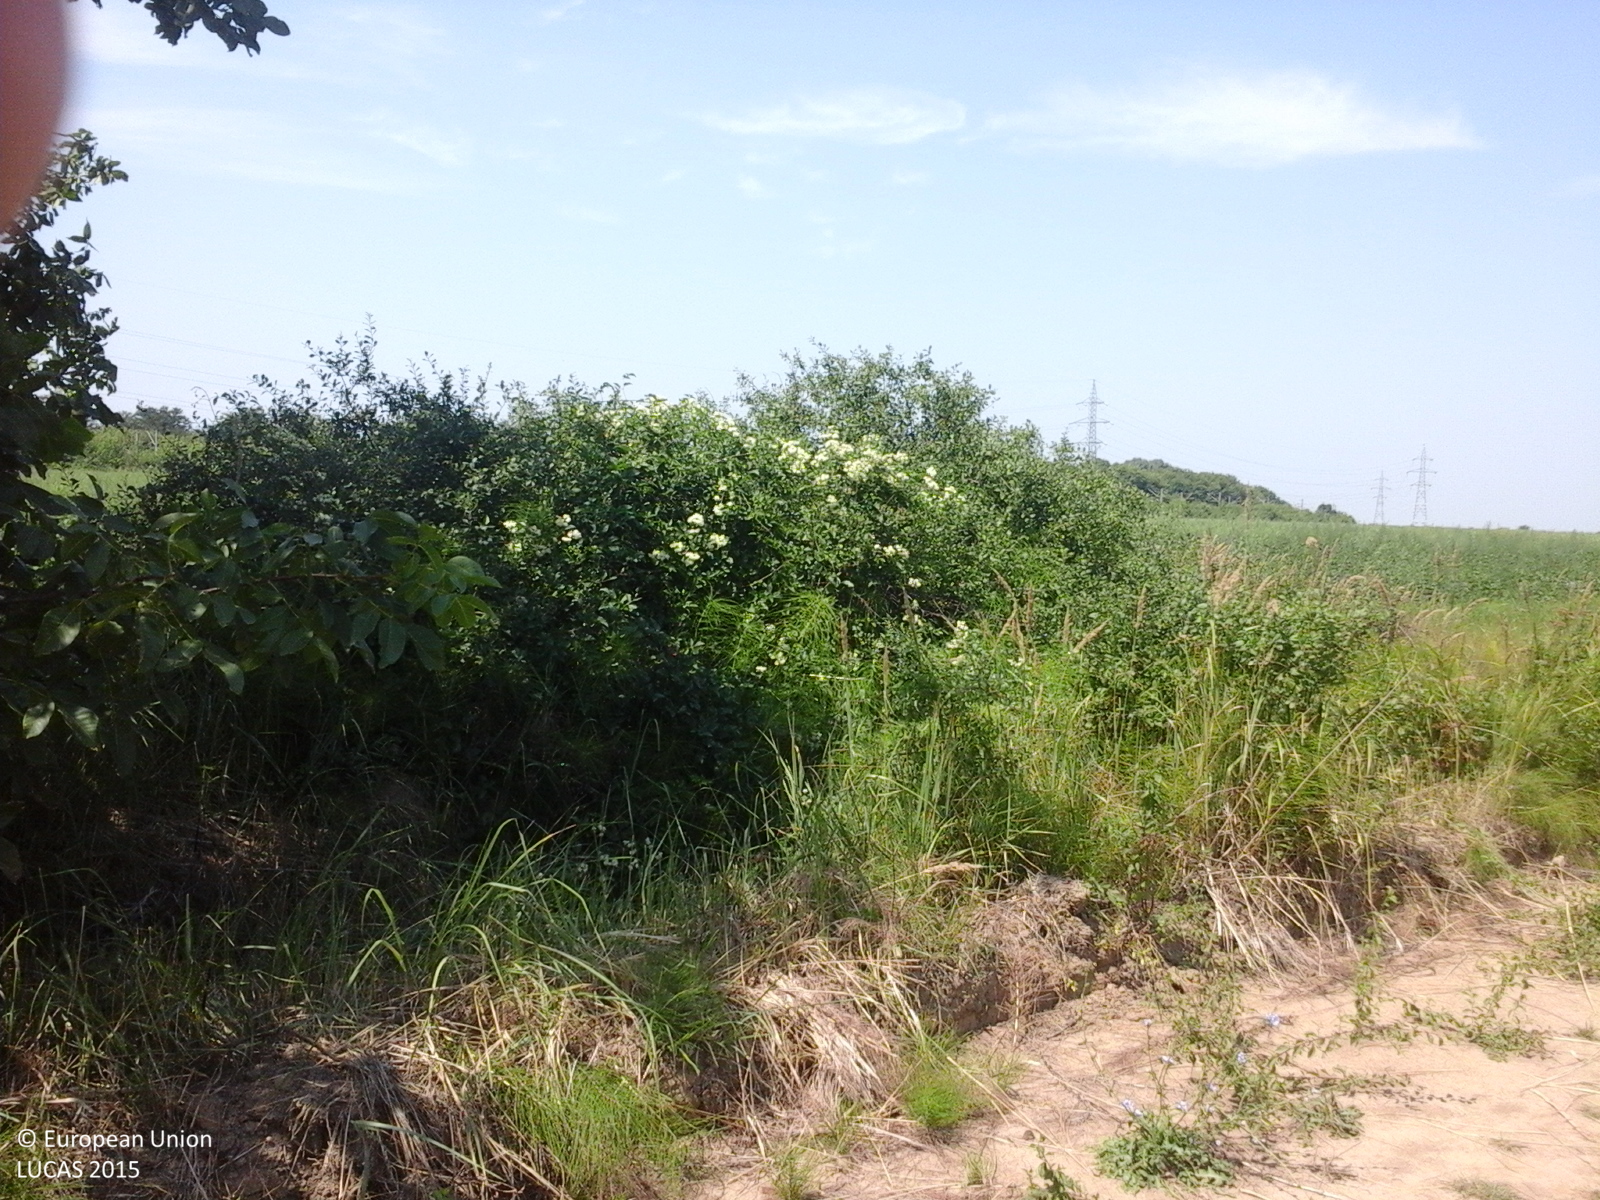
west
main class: Cropland
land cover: Maize
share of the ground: > 75 %
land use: Agriculture (excluding fallow land and kitchen gardens)
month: August
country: RO
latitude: 46.2485
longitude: 27.1014
